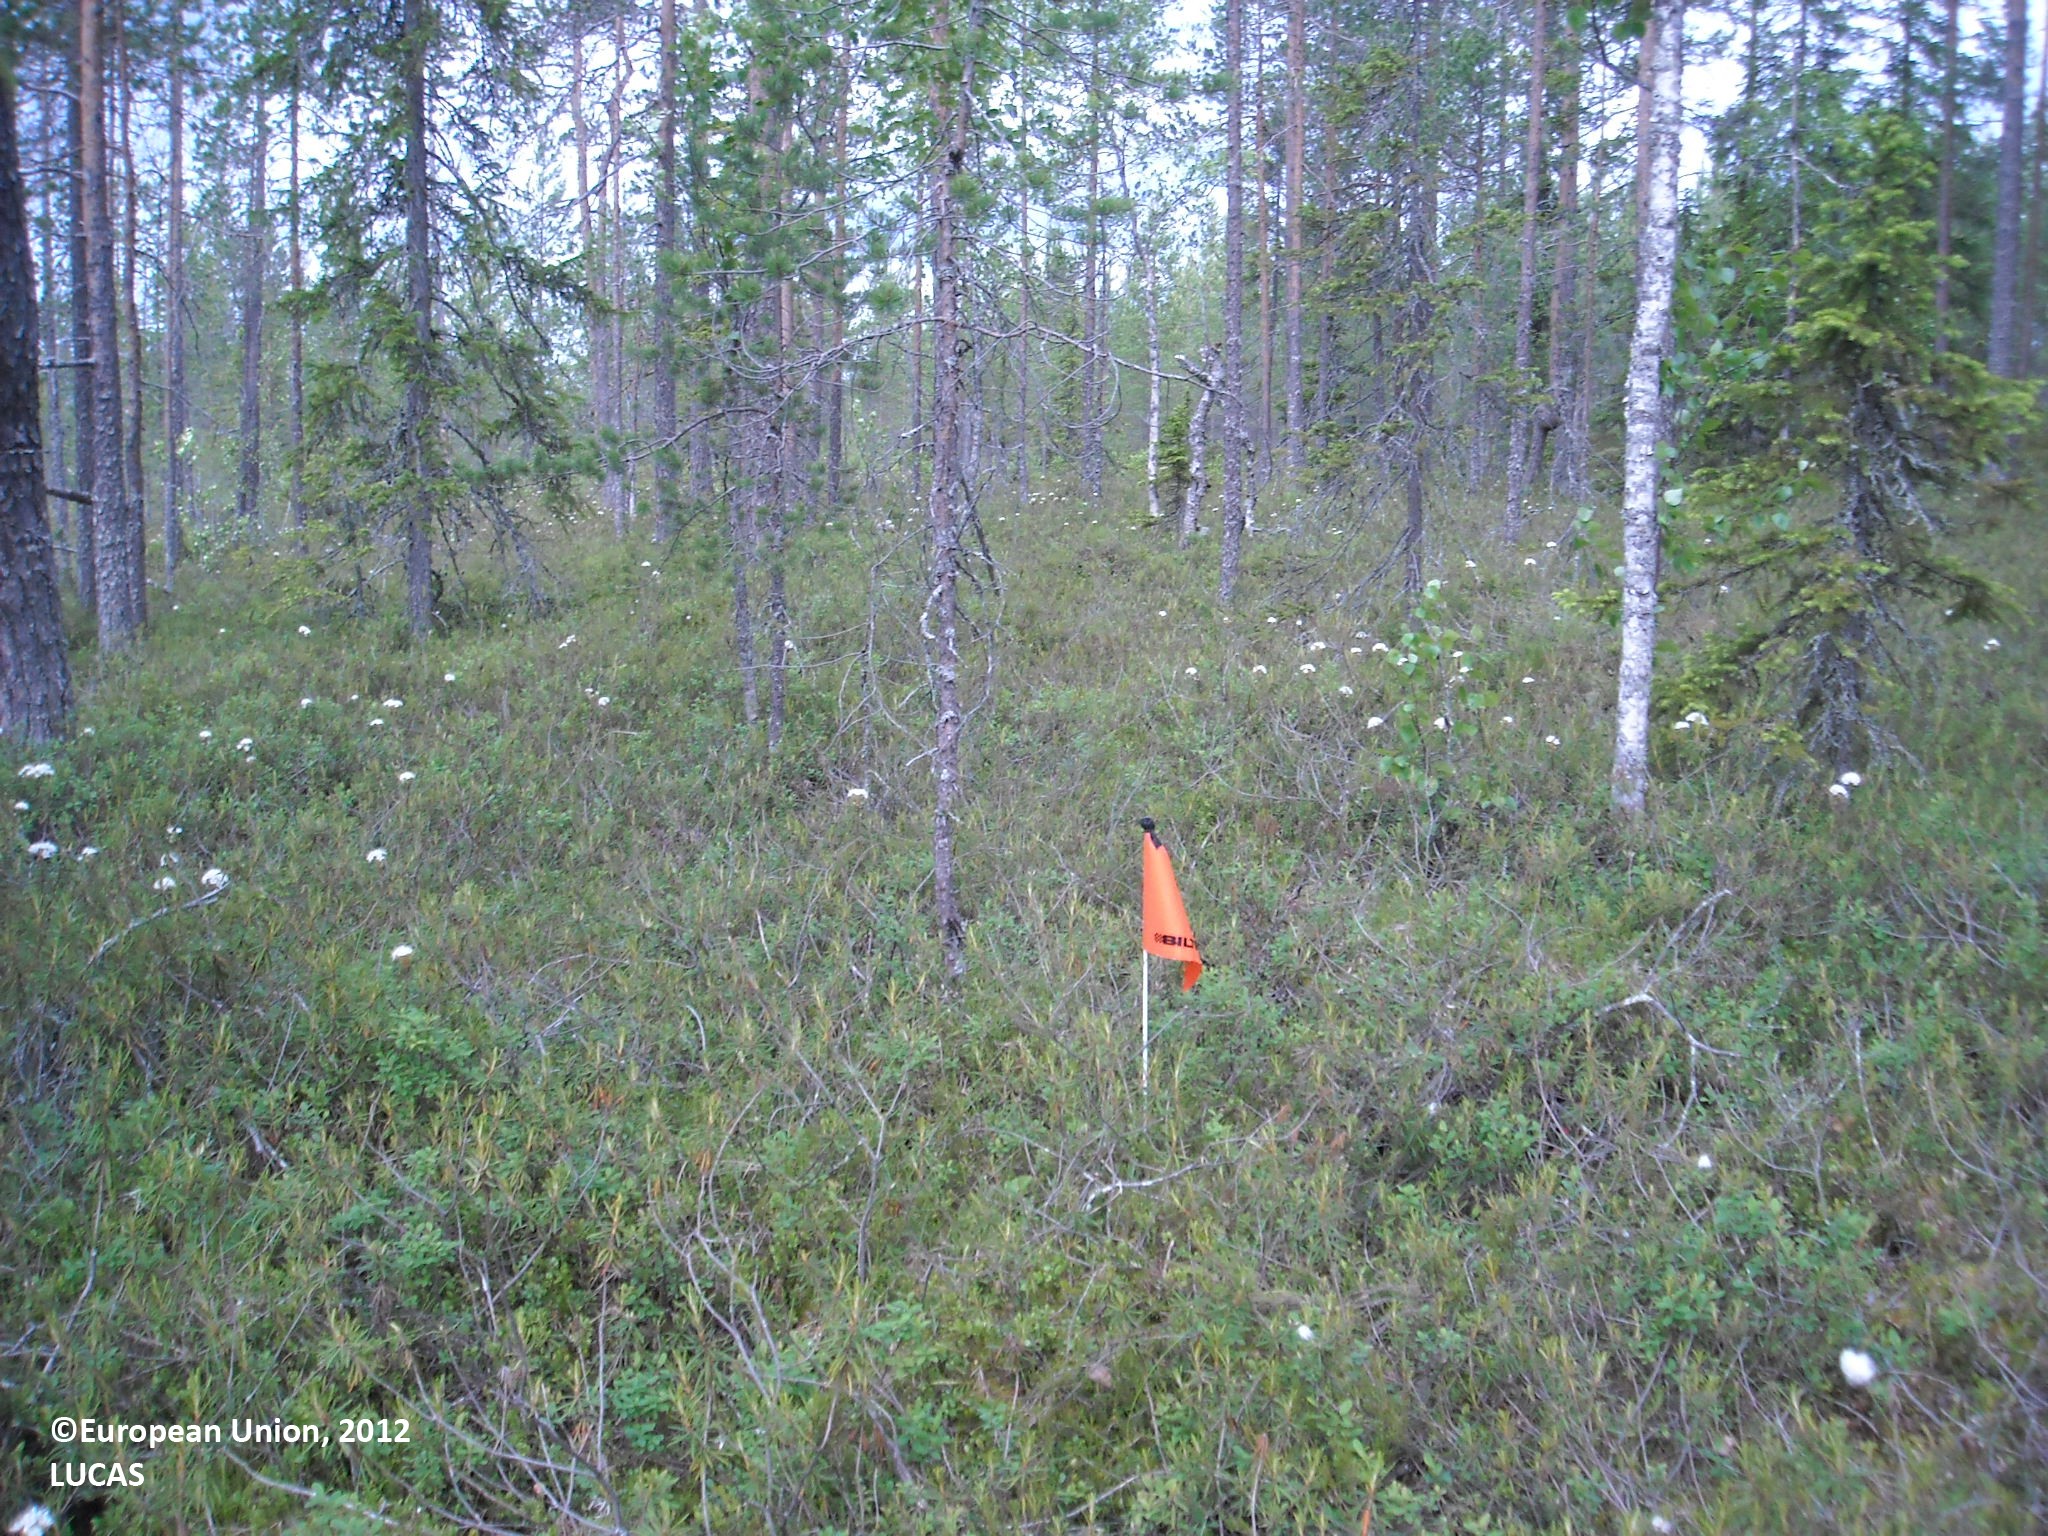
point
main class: Woodland
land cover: Pine dominated coniferous woodland
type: mire and swamp forests
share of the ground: > 75 %
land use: Forestry
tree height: > 5 m
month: June
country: FI
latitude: 64.8332
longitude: 27.7877
